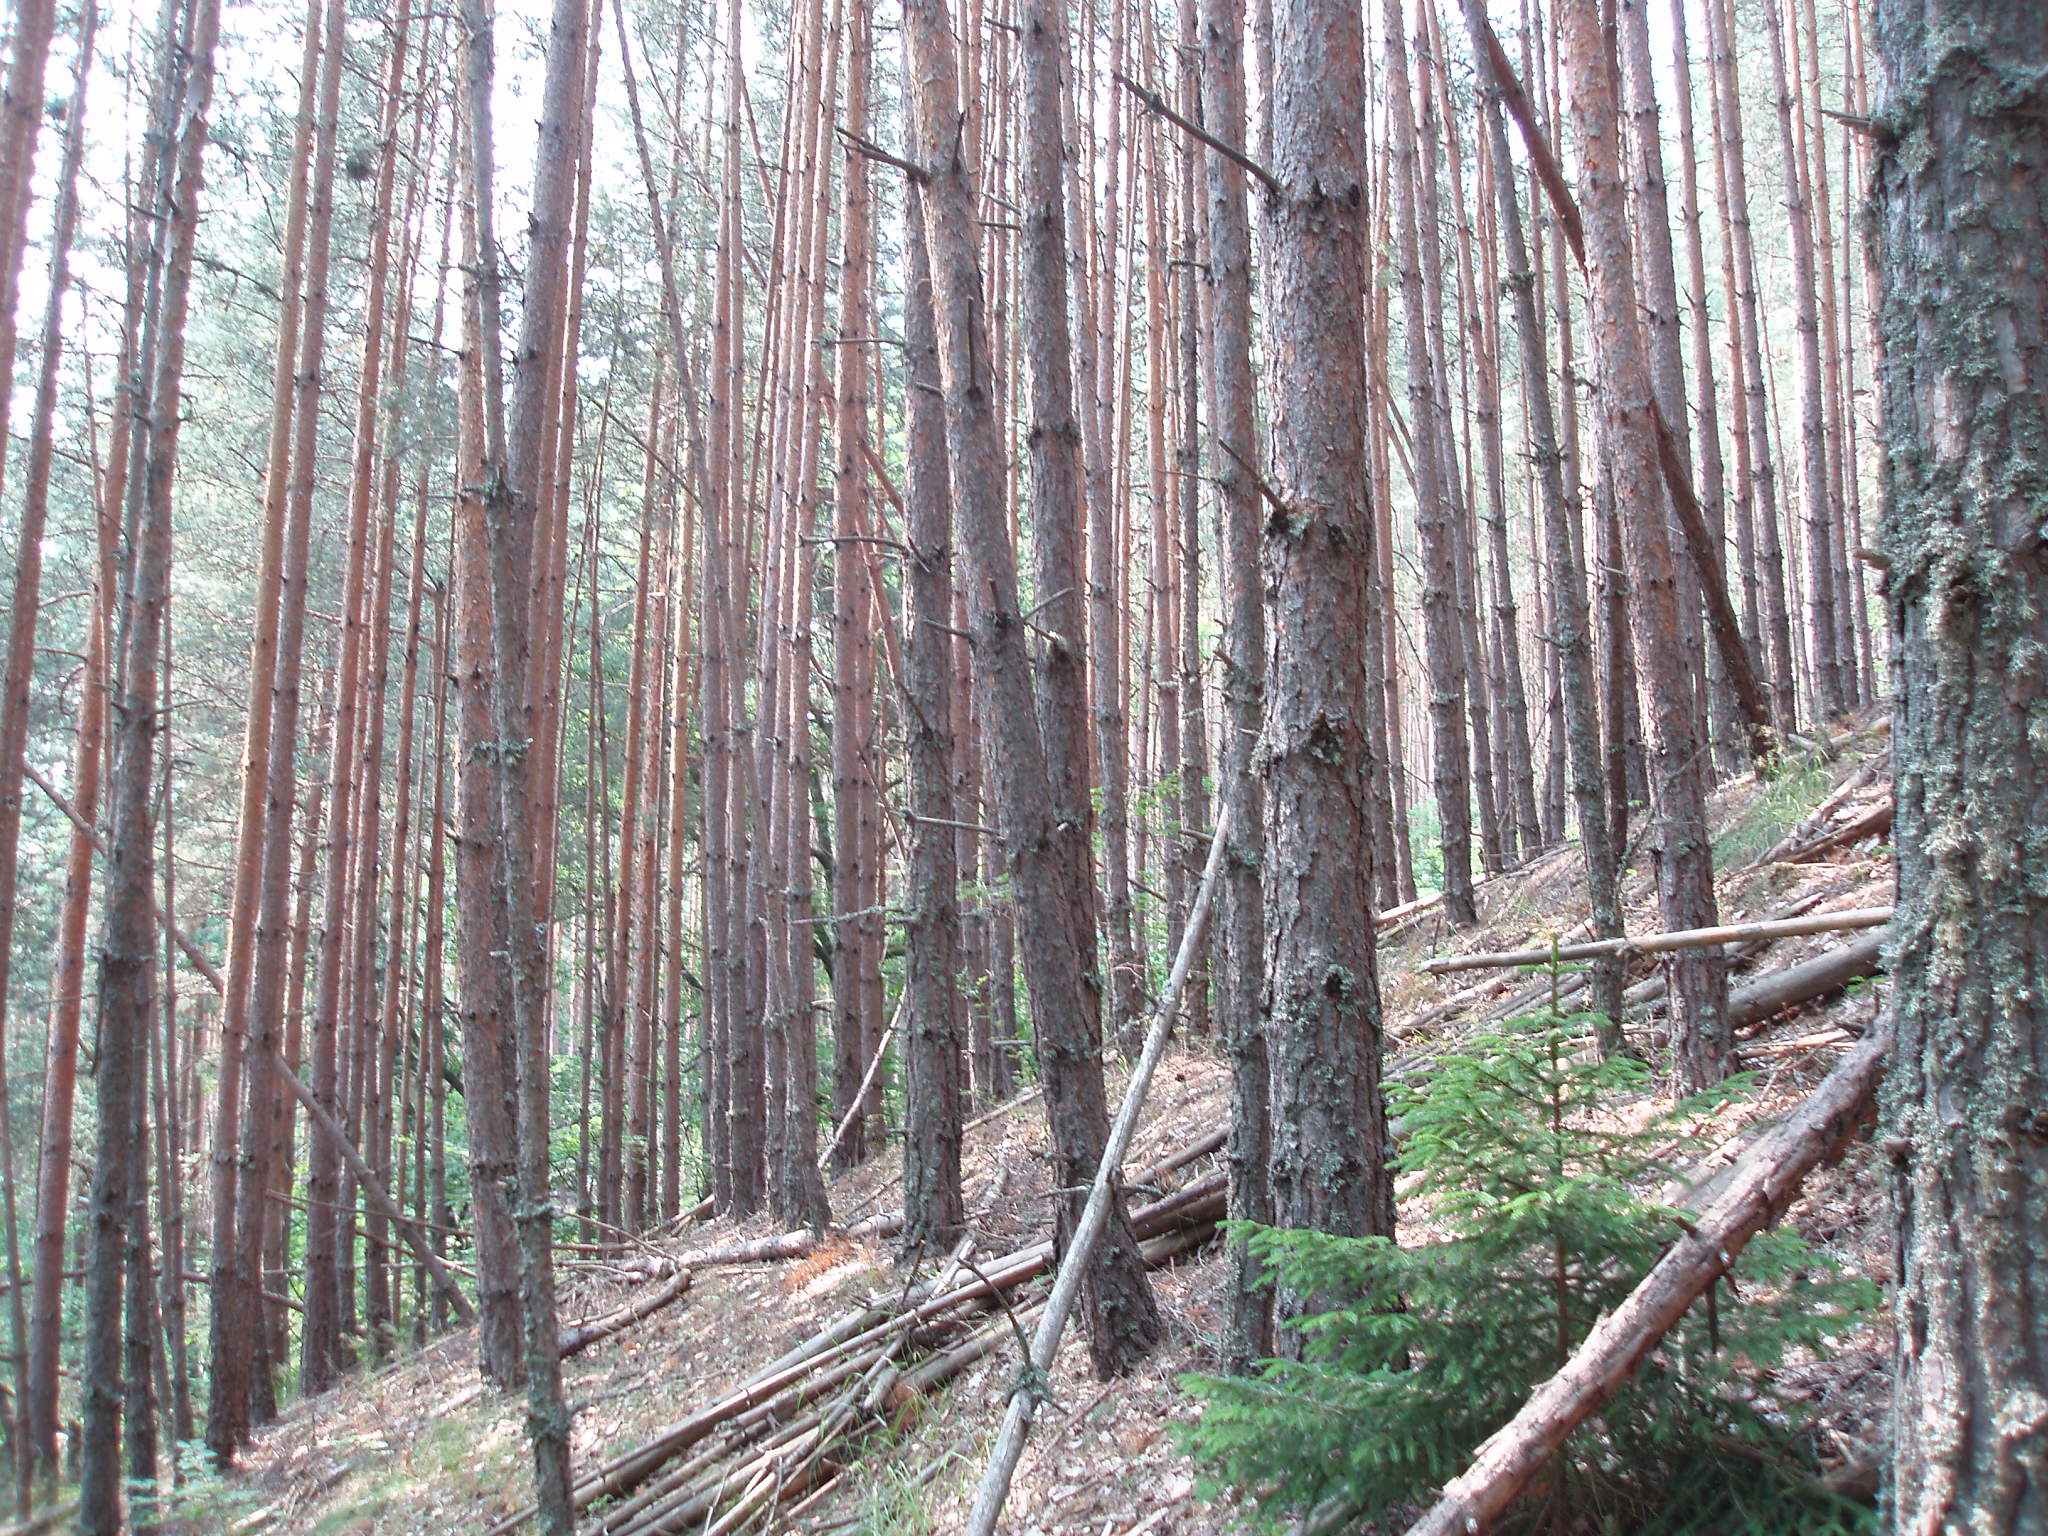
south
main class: Woodland
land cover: Pine dominated mixed woodland
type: hemiboreal forest and nemoral coniferous forest and mixed broadleaved-coniferous forest
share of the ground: > 75 %
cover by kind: coniferous forest trees 75 %, broadleaved forest trees 25 %
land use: Forestry
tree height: > 5 m
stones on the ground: > 50 %
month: July
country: BG
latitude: 42.0478
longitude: 23.6976
